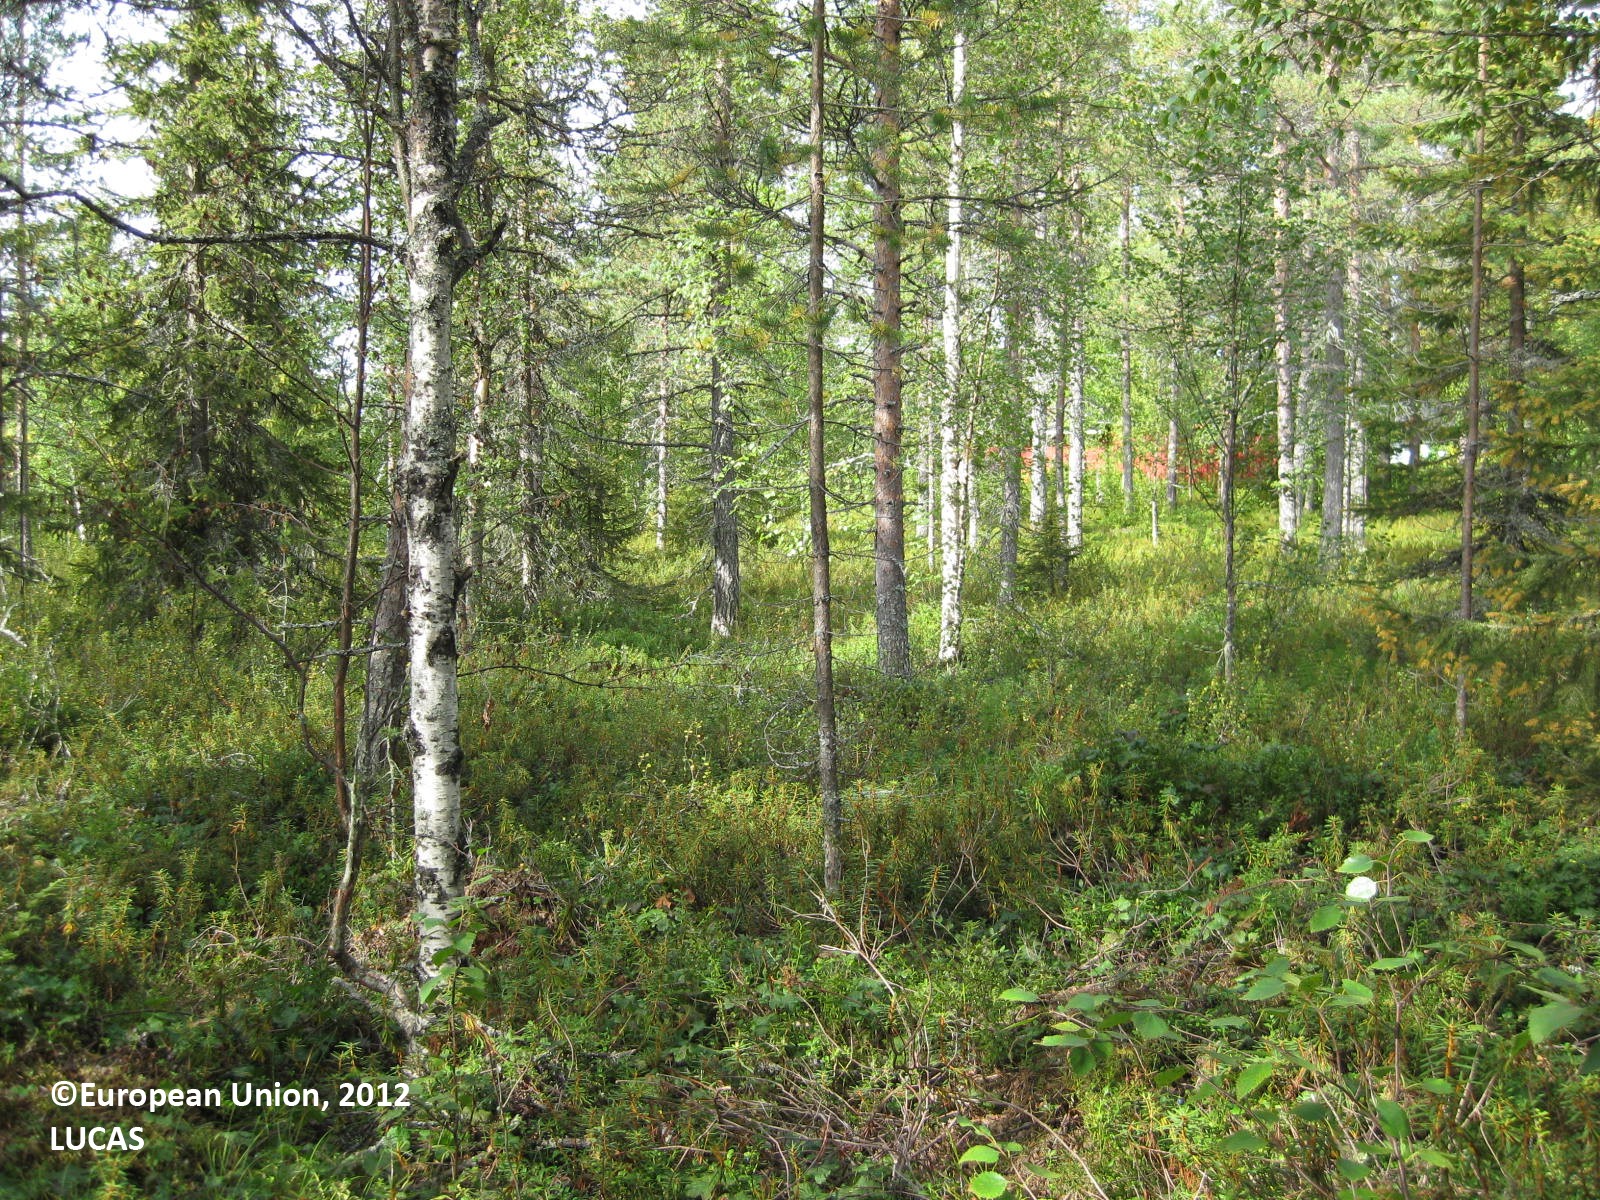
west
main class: Woodland
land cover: Pine dominated mixed woodland
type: boreal forest
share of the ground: > 75 %
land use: Forestry
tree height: > 5 m
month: August
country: FI
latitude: 66.2445
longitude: 28.8722
